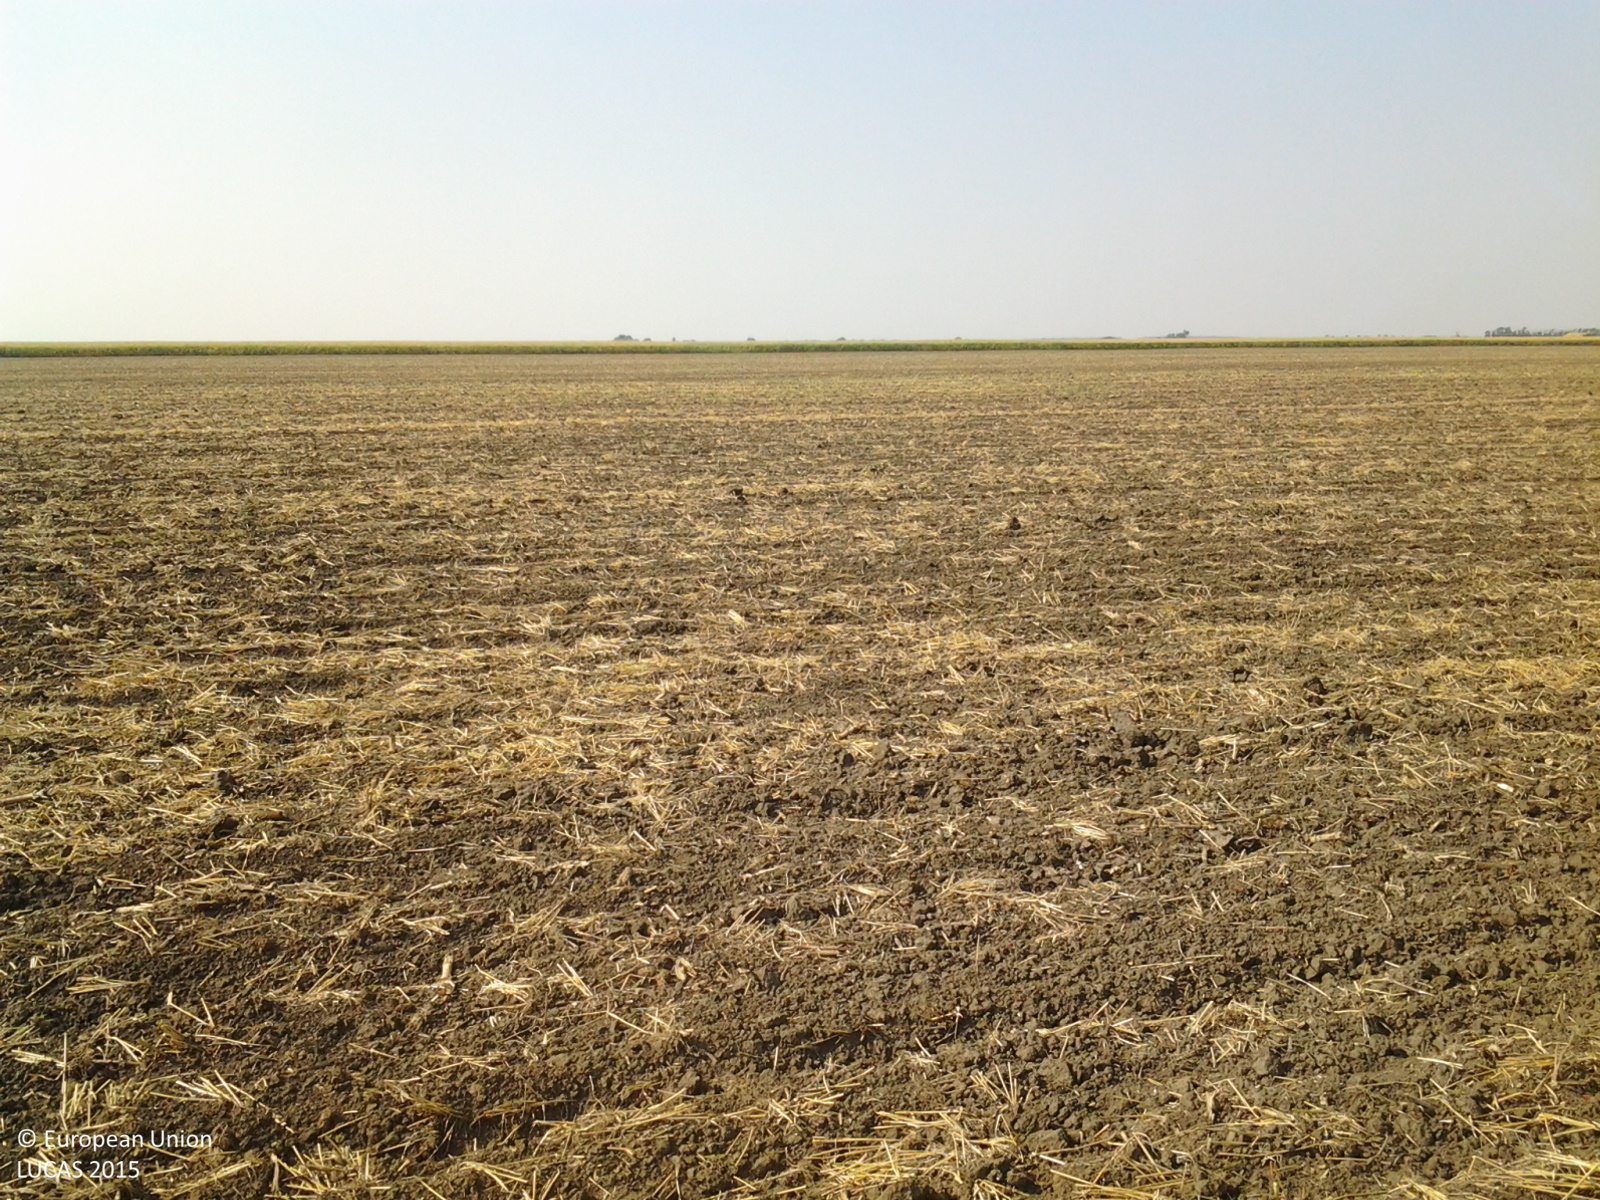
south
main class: Cropland
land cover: Common wheat
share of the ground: 10 - 25 %
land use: Agriculture (excluding fallow land and kitchen gardens)
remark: Harvested field
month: August
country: HU
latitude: 46.3131
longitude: 21.1354
